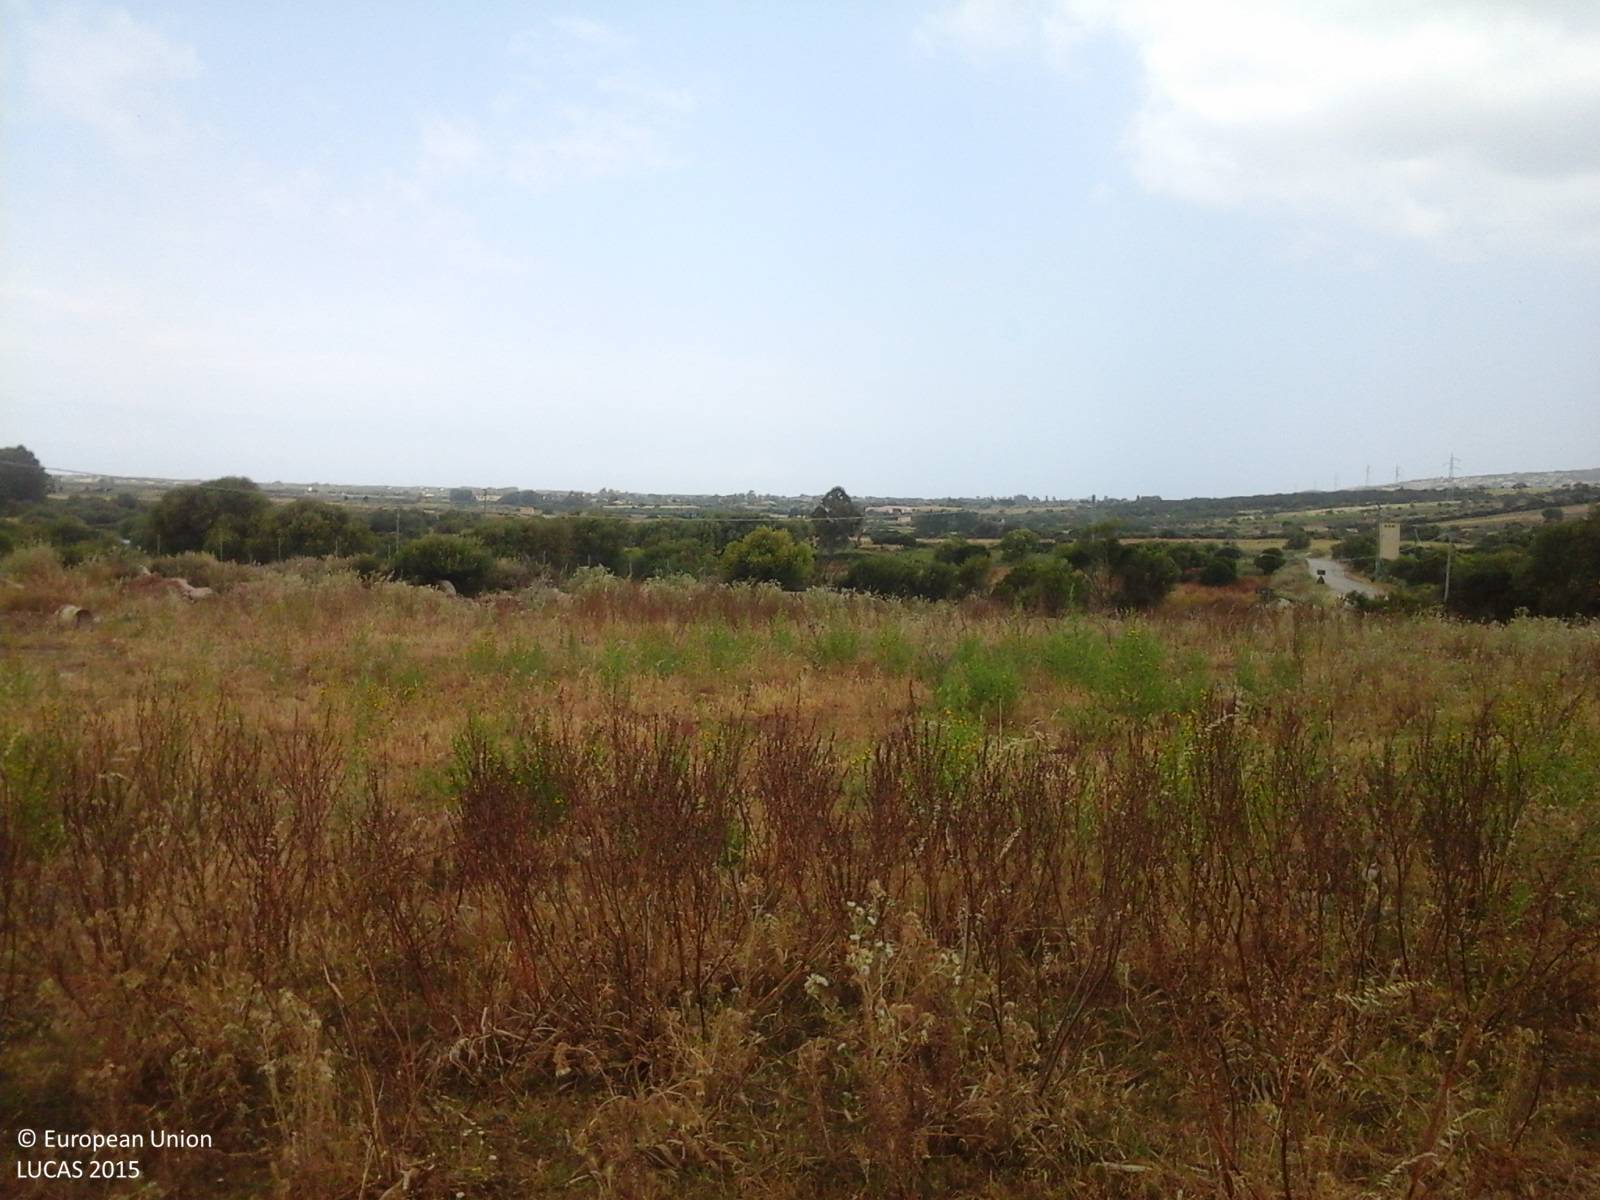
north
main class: Grassland
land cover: Spontaneously vegetated surfaces
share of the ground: > 75 %
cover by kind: herbaceous plants 100 %
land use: Agriculture (excluding fallow land and kitchen gardens)
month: May
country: IT
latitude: 40.9305
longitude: 8.8770
